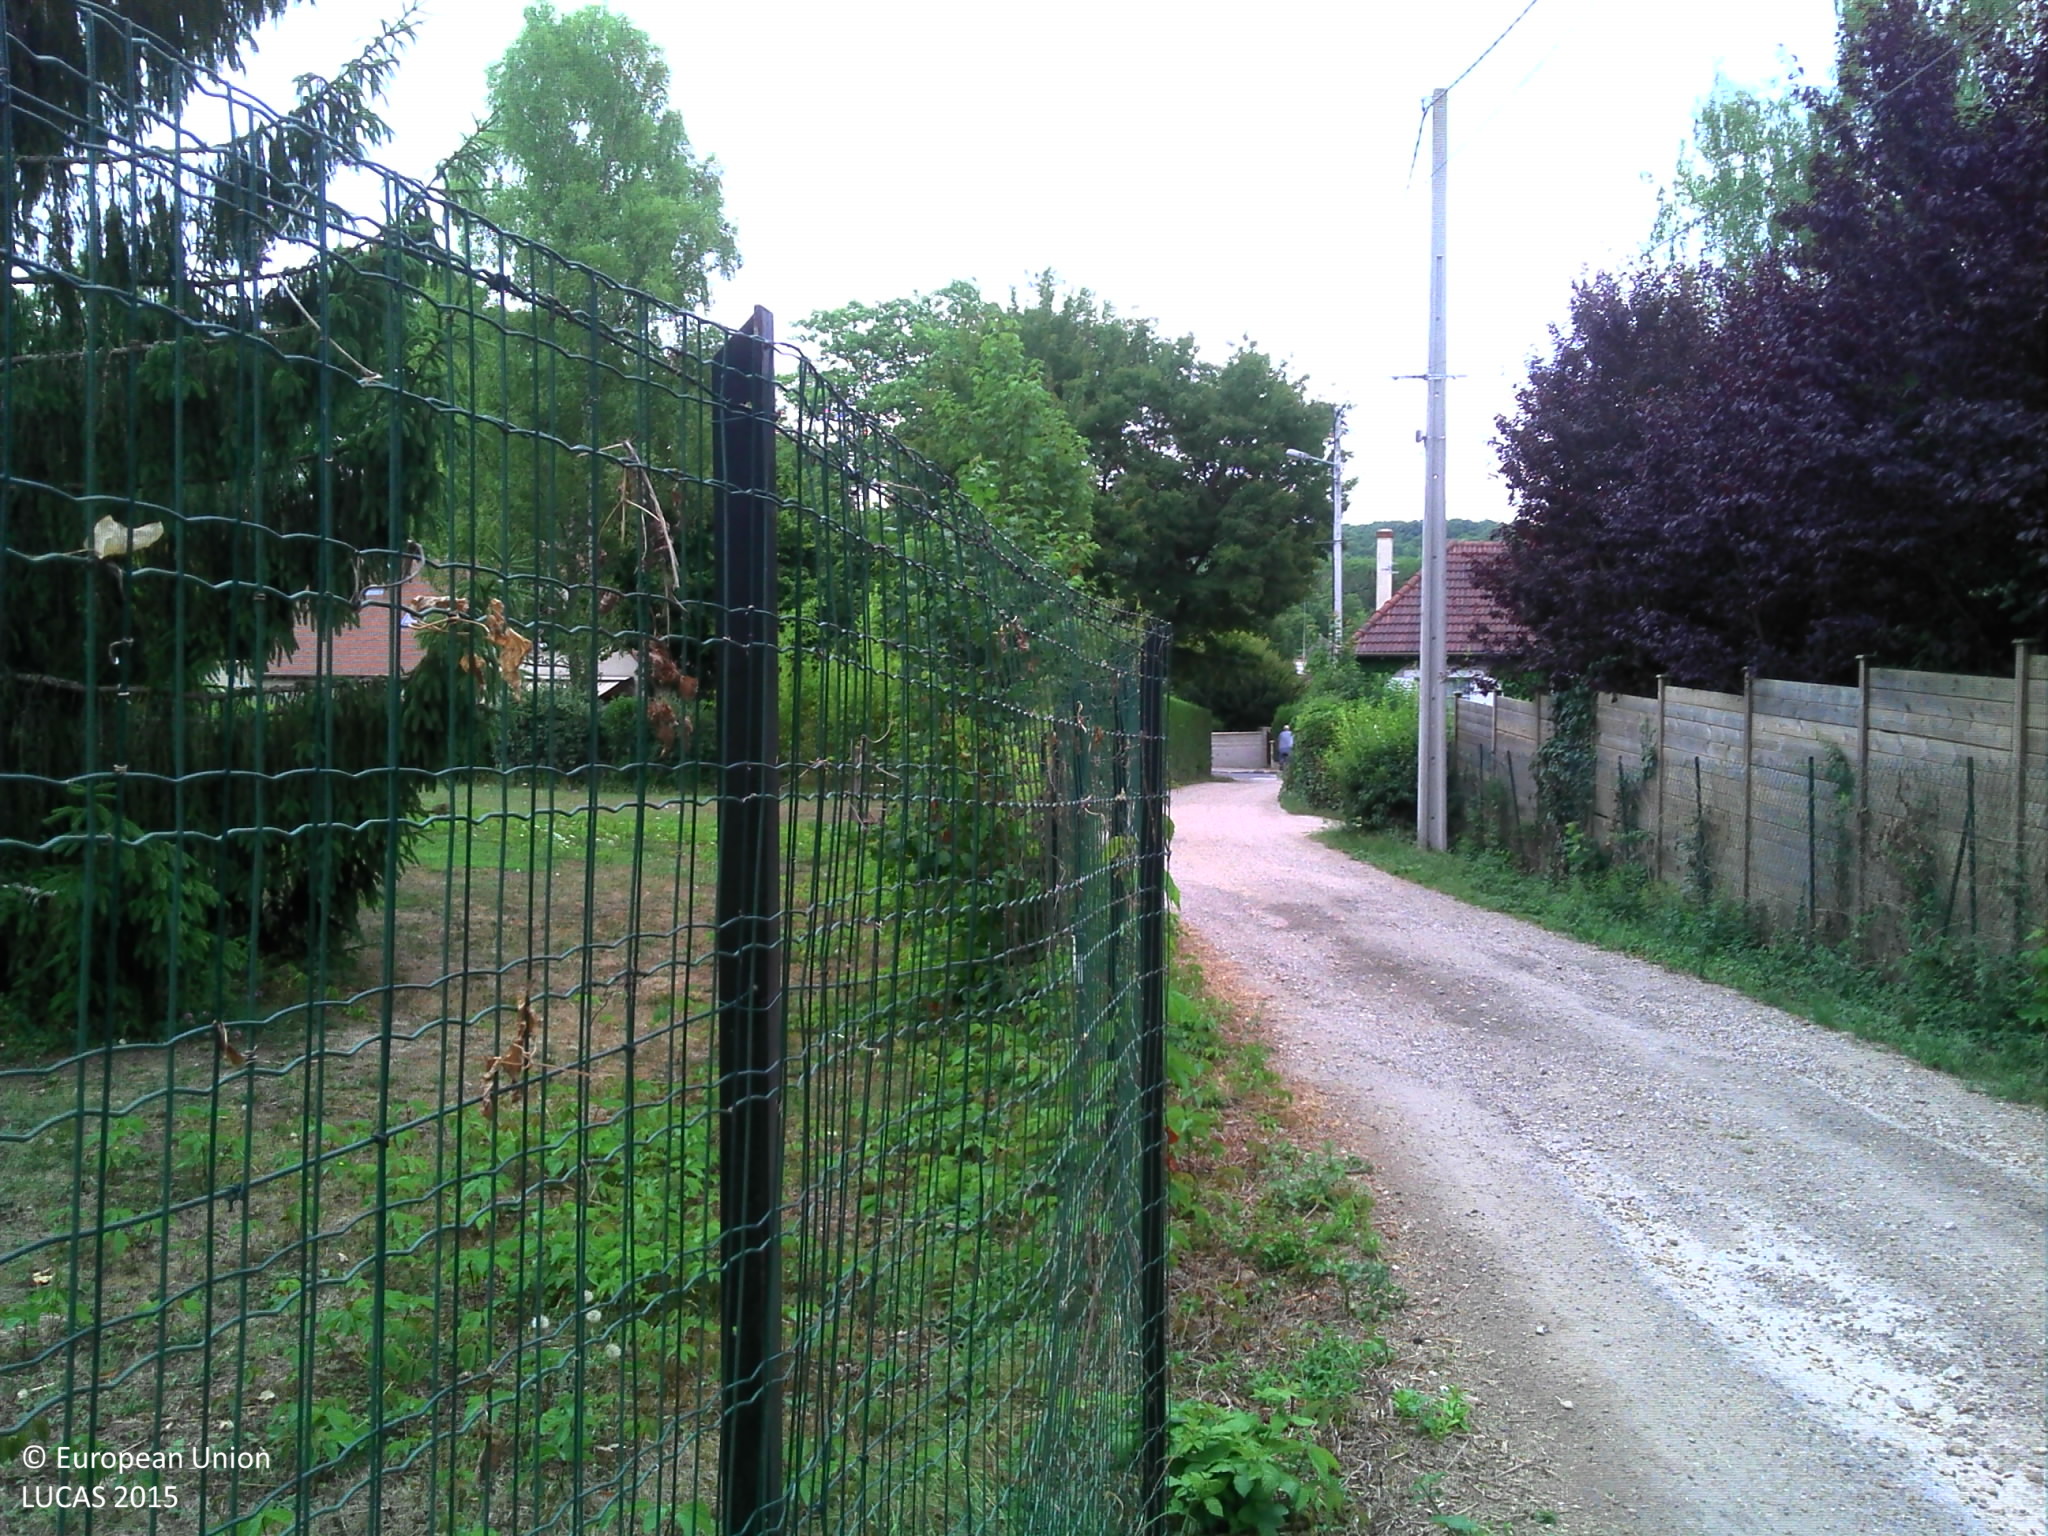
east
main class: Woodland
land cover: Broadleaved woodland
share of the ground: > 75 %
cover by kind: broadleaved forest trees 50 %, herbaceous plants 25 %, lichens and mosses 10 %, unconsolidated bare surface 10 %, coniferous forest trees 5 %
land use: Residential
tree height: > 5 m
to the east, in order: Broadleaved woodland; Fences; Grassland with sparse tree/shrub cover; Artificial constructions in urban areas; Broadleaved woodland; Artificial constructions in urban areas
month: July
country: FR
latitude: 48.4548
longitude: 2.7567
